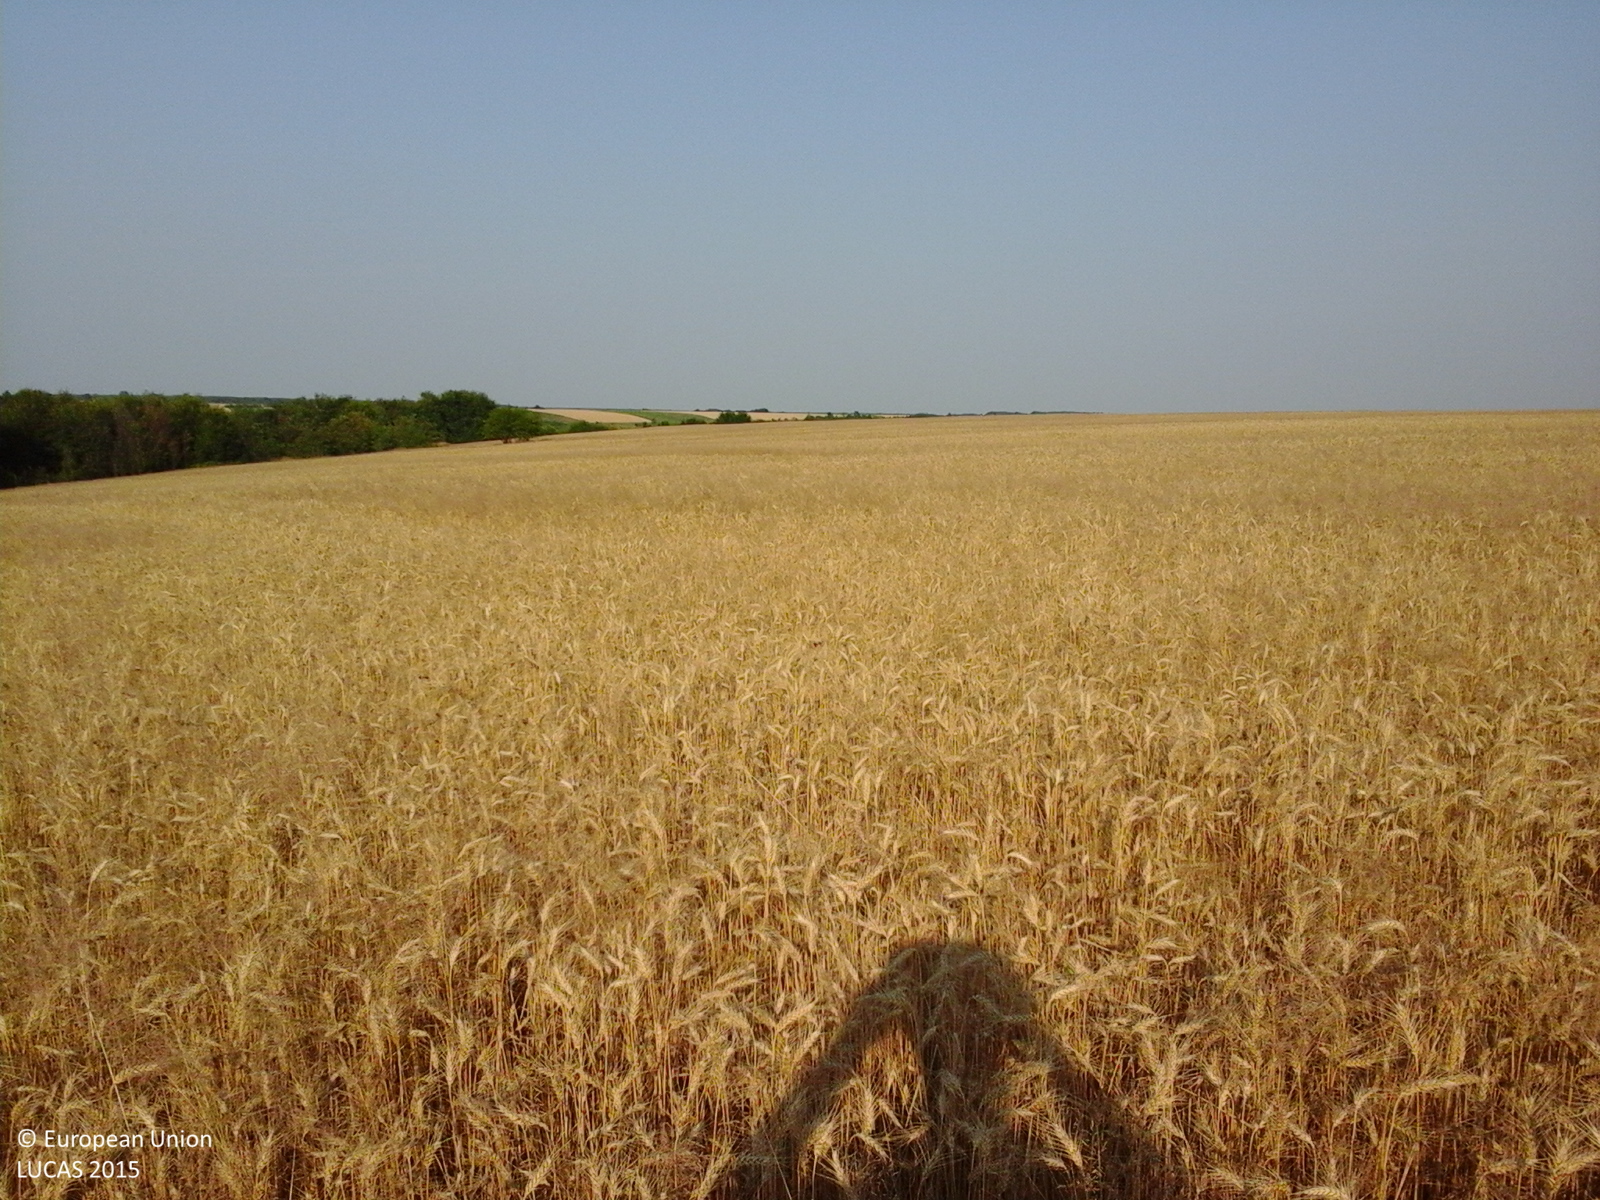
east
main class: Cropland
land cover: Common wheat
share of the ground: > 75 %
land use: Agriculture (excluding fallow land and kitchen gardens)
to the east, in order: Common wheat
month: July
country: RO
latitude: 44.6882
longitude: 24.7005
